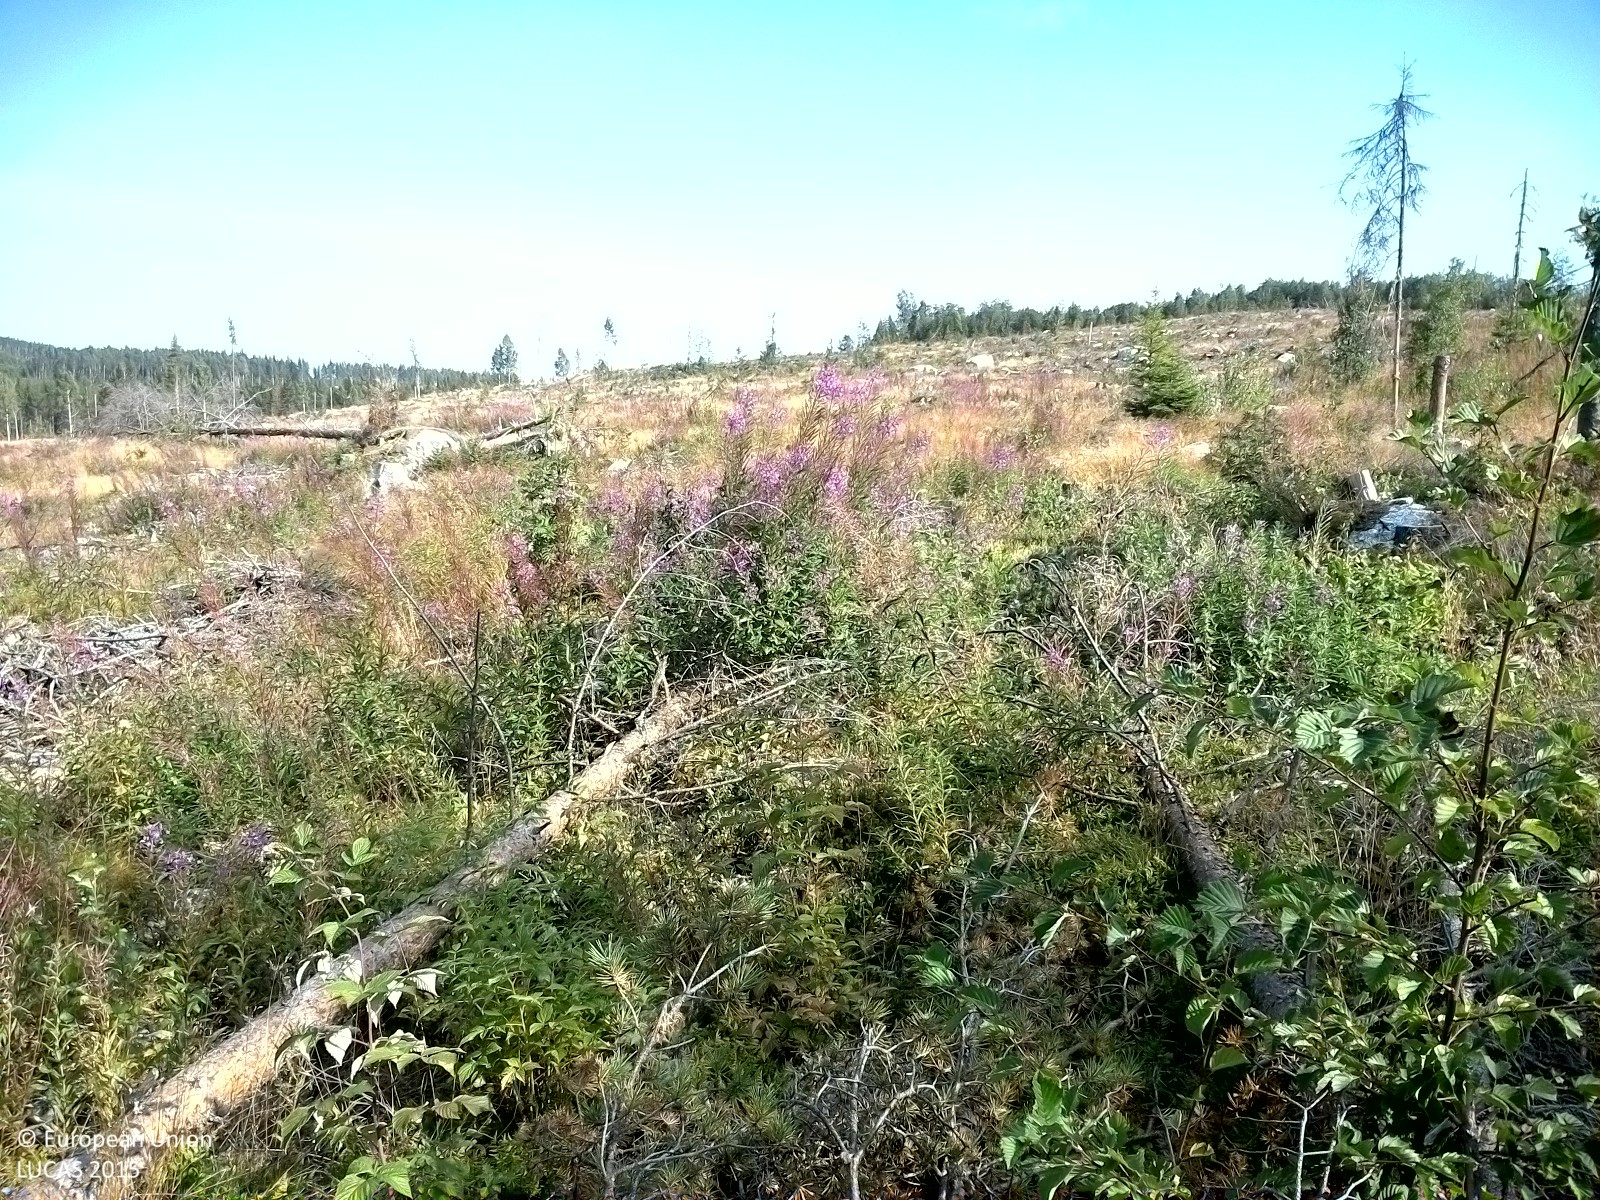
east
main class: Woodland
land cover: Broadleaved woodland
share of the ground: 10 - 25 %
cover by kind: herbaceous plants 40 %, shrubs 20 %, broadleaved forest trees 10 %
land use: Forestry
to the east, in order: Broadleaved woodland; Grassland with sparse tree/shrub cover; Other mixed woodland
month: August
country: SE
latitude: 62.4290
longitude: 16.2349
